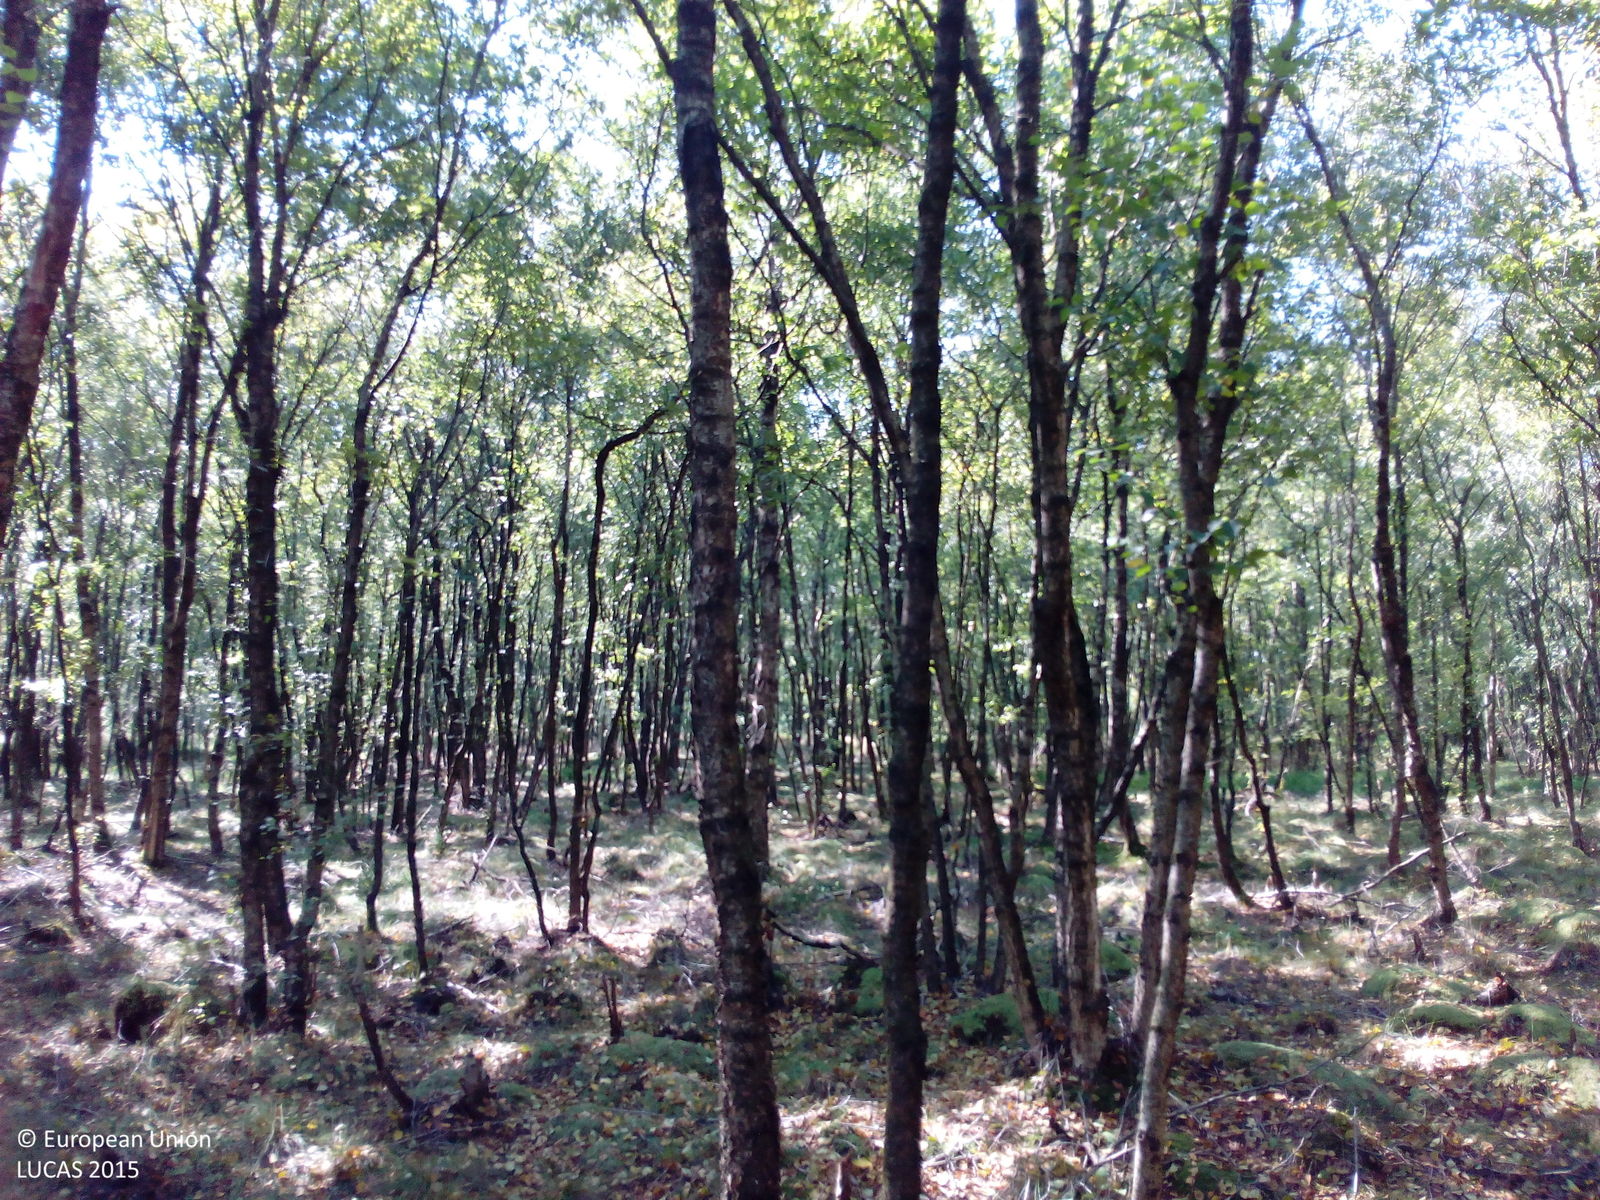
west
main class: Woodland
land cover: Broadleaved woodland
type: non-riverine alder, birch or aspen forest
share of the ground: > 75 %
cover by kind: broadleaved forest trees 80 %, herbaceous plants 10 %, shrubs 5 %, lichens and mosses 5 %
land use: Forestry
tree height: > 5 m
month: August
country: DE
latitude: 52.7921
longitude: 7.9986
